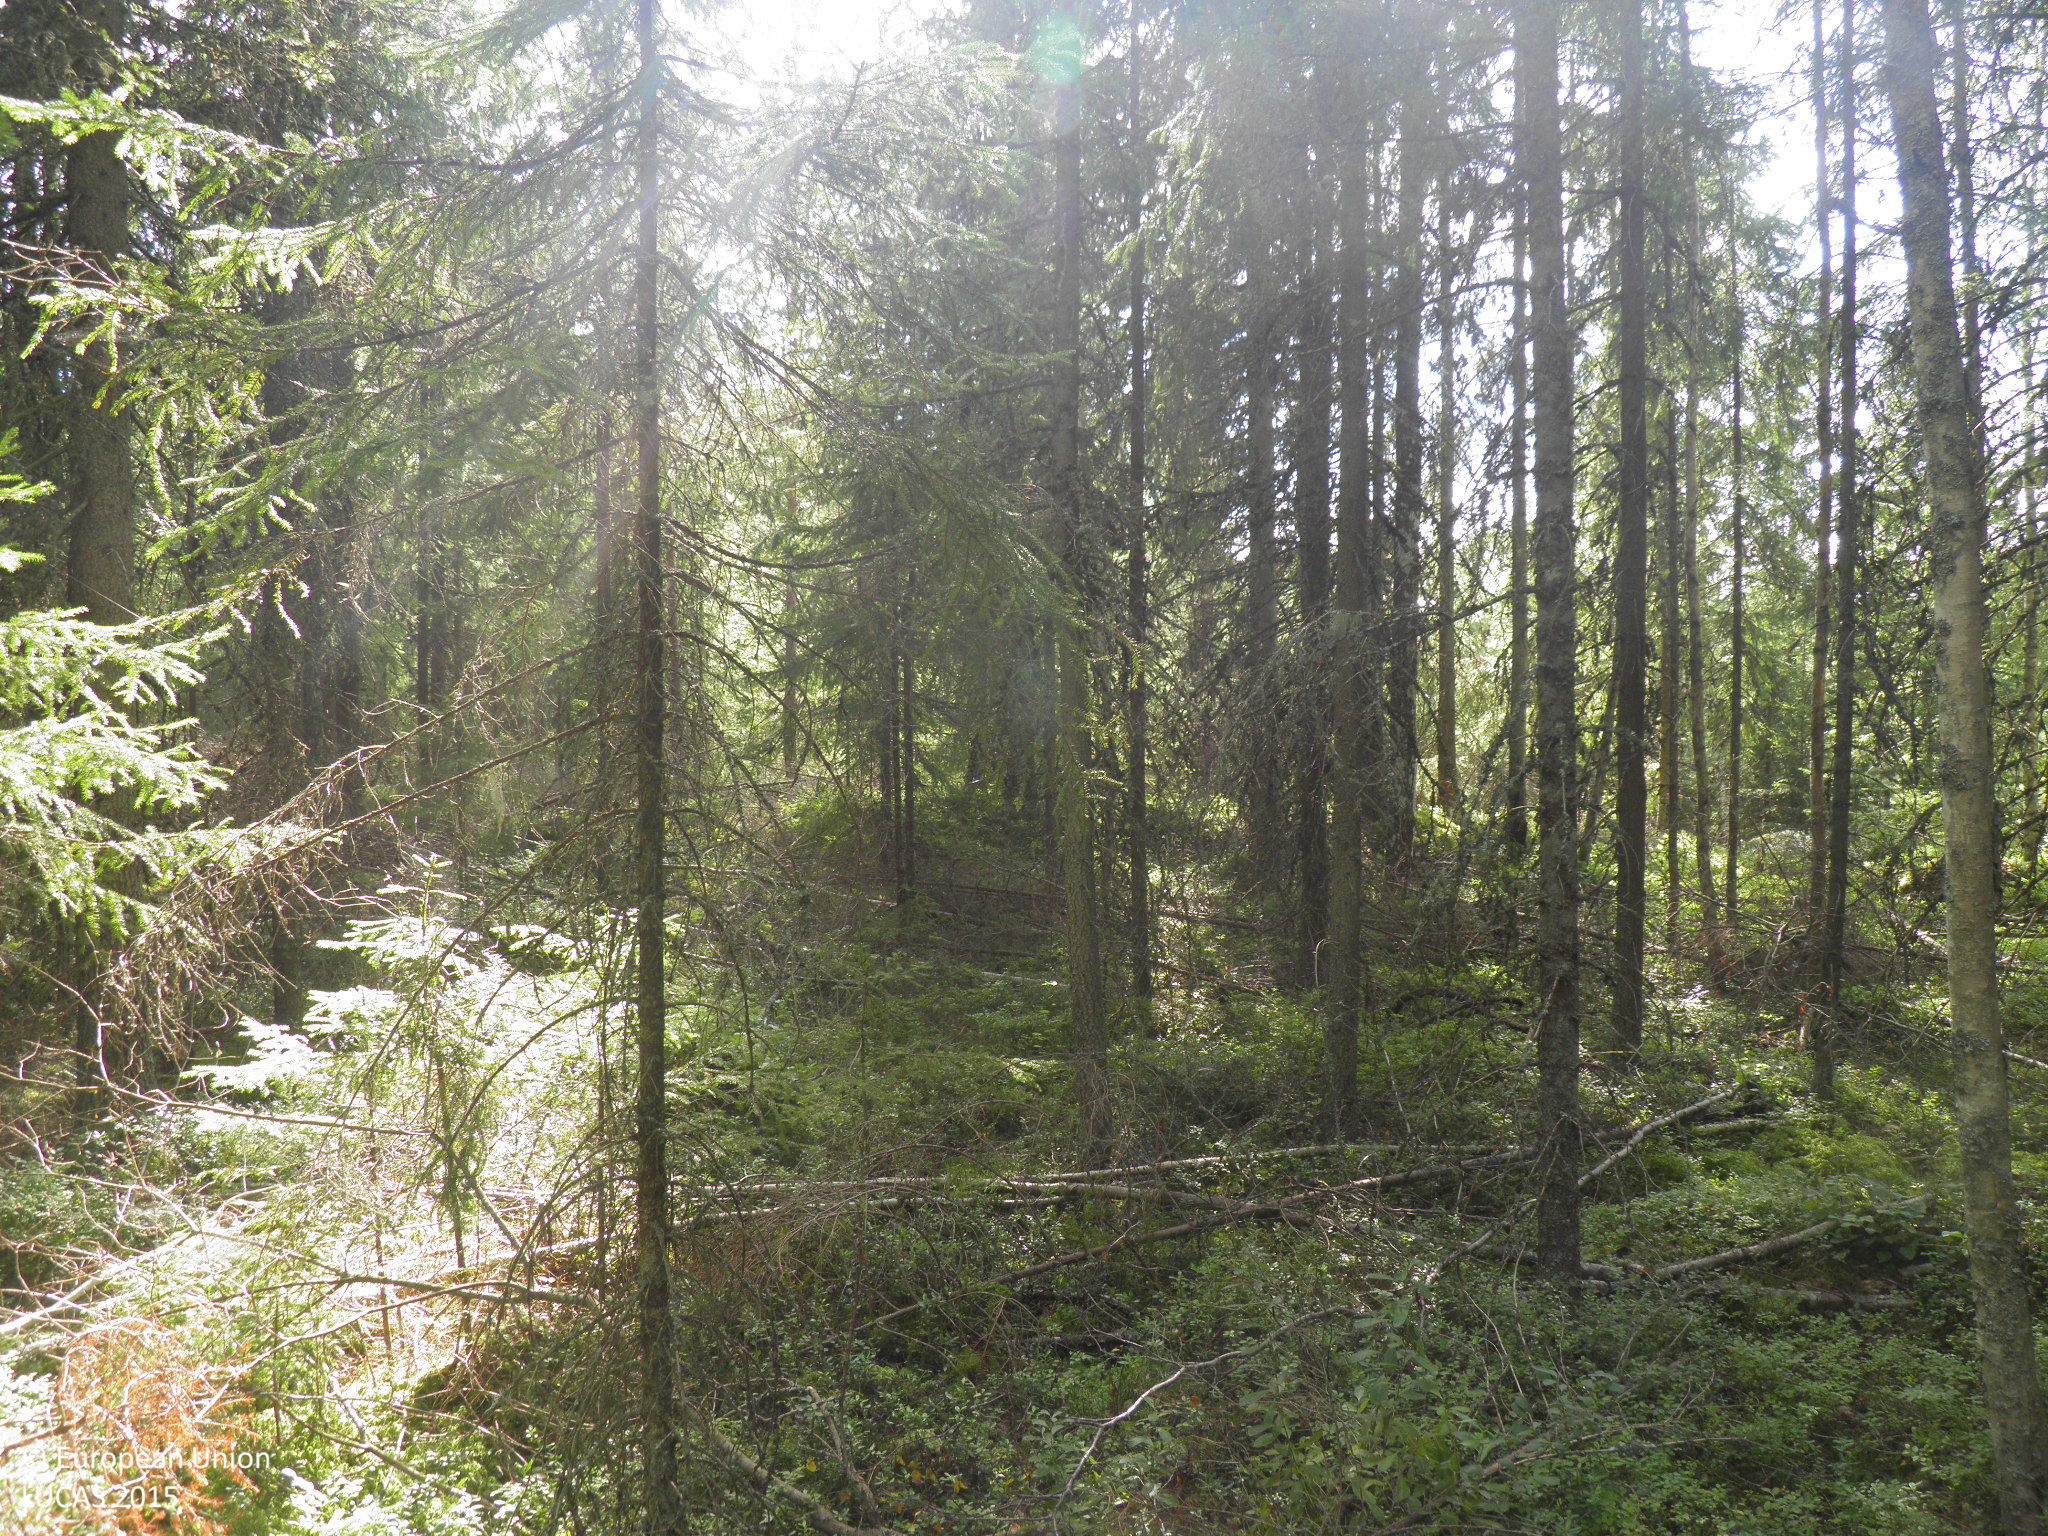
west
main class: Woodland
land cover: Spruce dominated coniferous woodland
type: hemiboreal forest and nemoral coniferous forest and mixed broadleaved-coniferous forest
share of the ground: 50 - 75 %
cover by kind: coniferous forest trees 50 %, shrubs 20 %, lichens and mosses 20 %, broadleaved forest trees 10 %
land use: Forestry
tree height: > 5 m
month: August
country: FI
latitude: 61.1326
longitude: 22.5634
